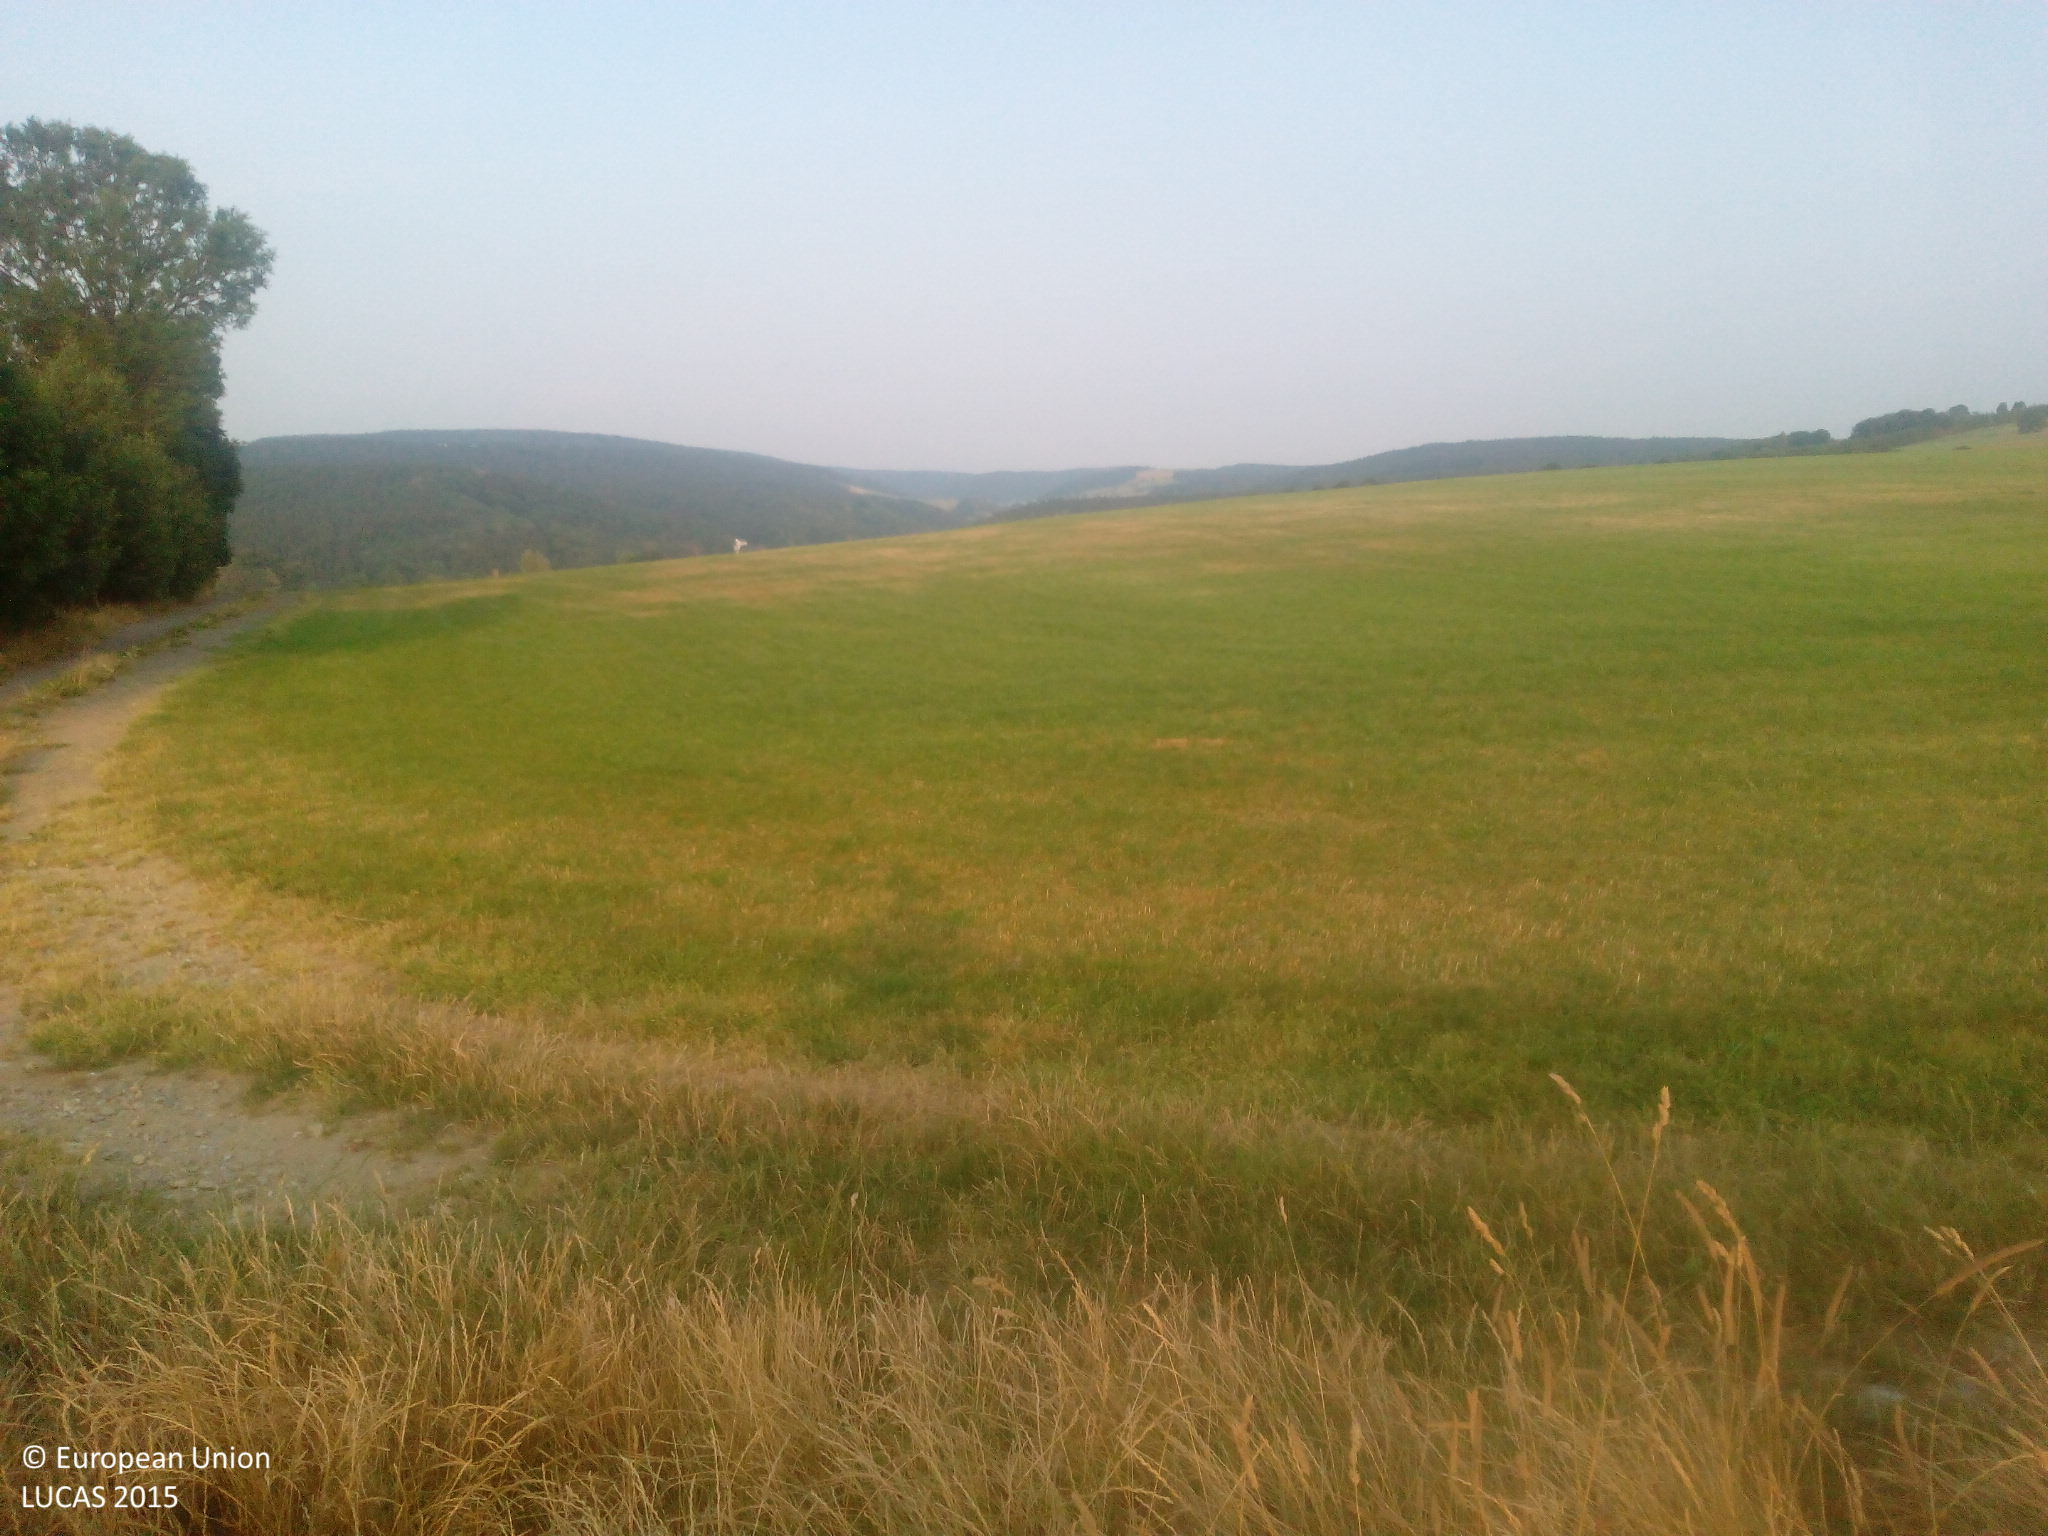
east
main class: Cropland
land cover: Maize
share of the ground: > 75 %
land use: Agriculture (excluding fallow land and kitchen gardens)
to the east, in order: Maize; Grassland without tree/shrub cover; Tracks; Grassland without tree/shrub cover
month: August
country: DE
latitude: 50.7425
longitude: 13.5007
